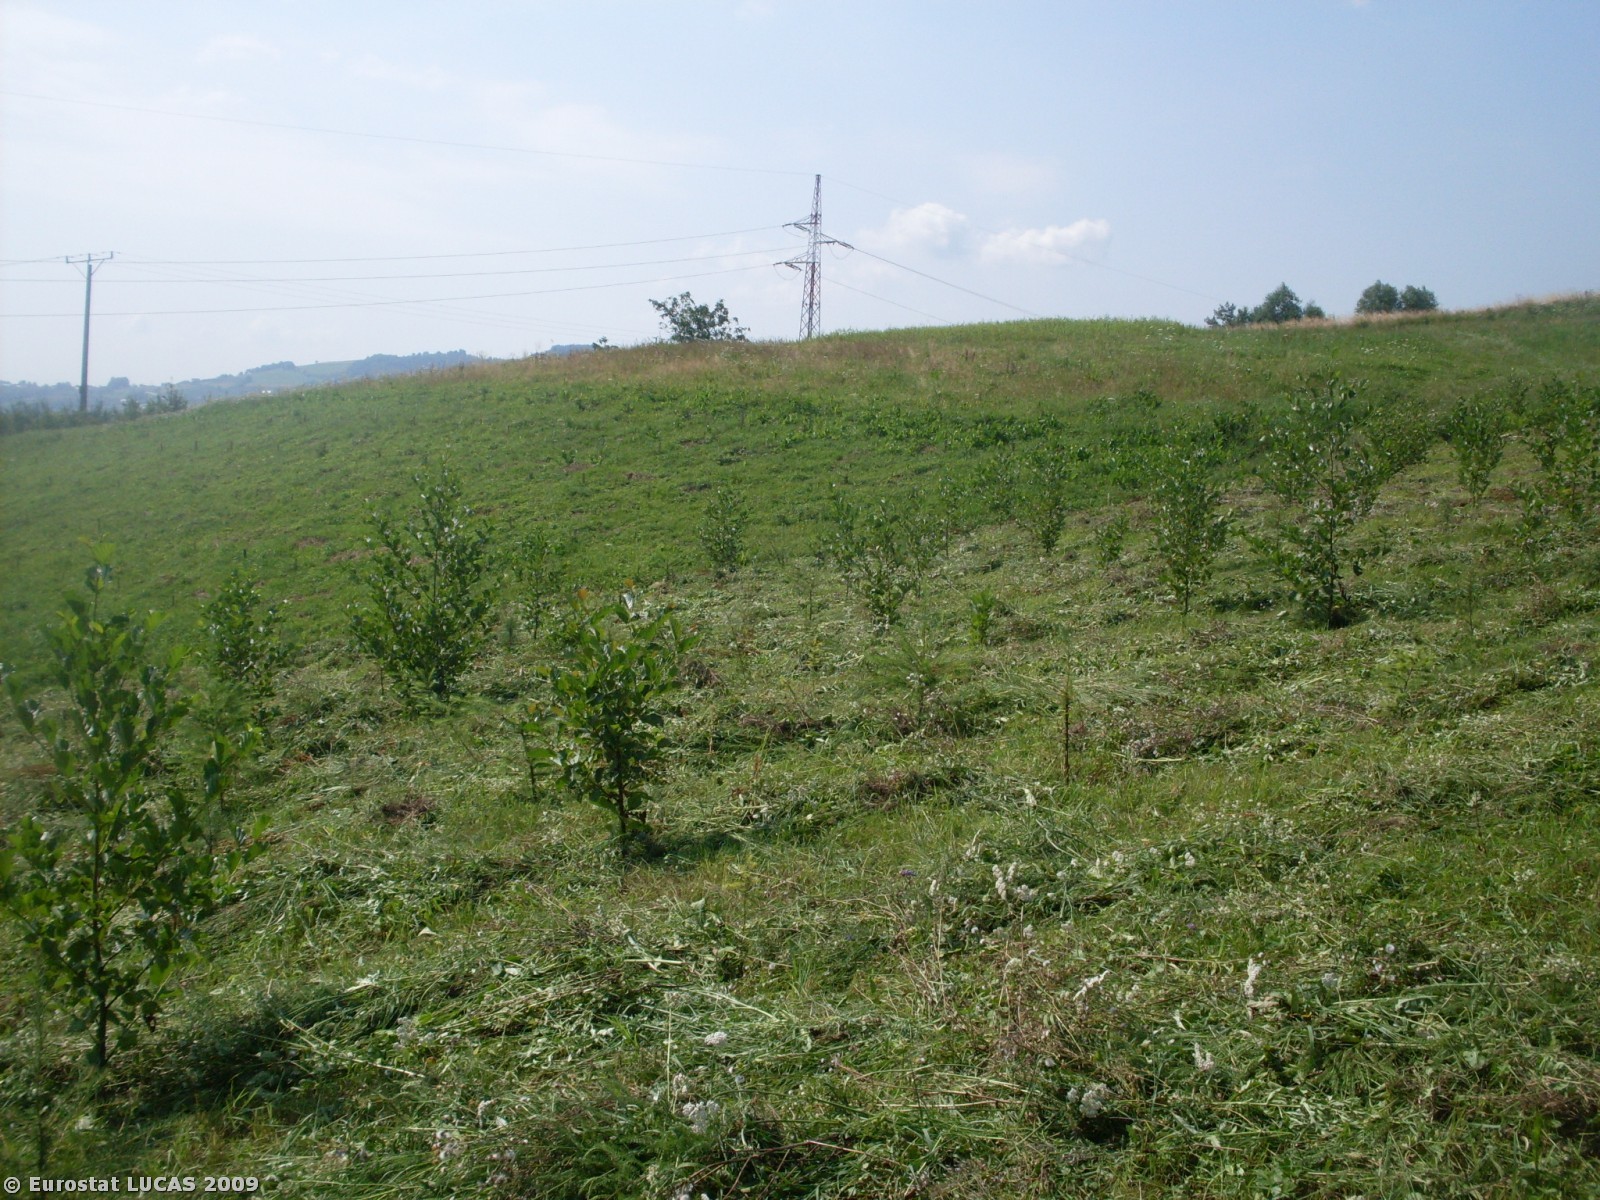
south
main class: Grassland
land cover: Grassland with sparse tree/shrub cover
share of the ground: > 75 %
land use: Agriculture (excluding fallow land and kitchen gardens)
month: July
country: PL
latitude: 49.7583
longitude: 20.6303
